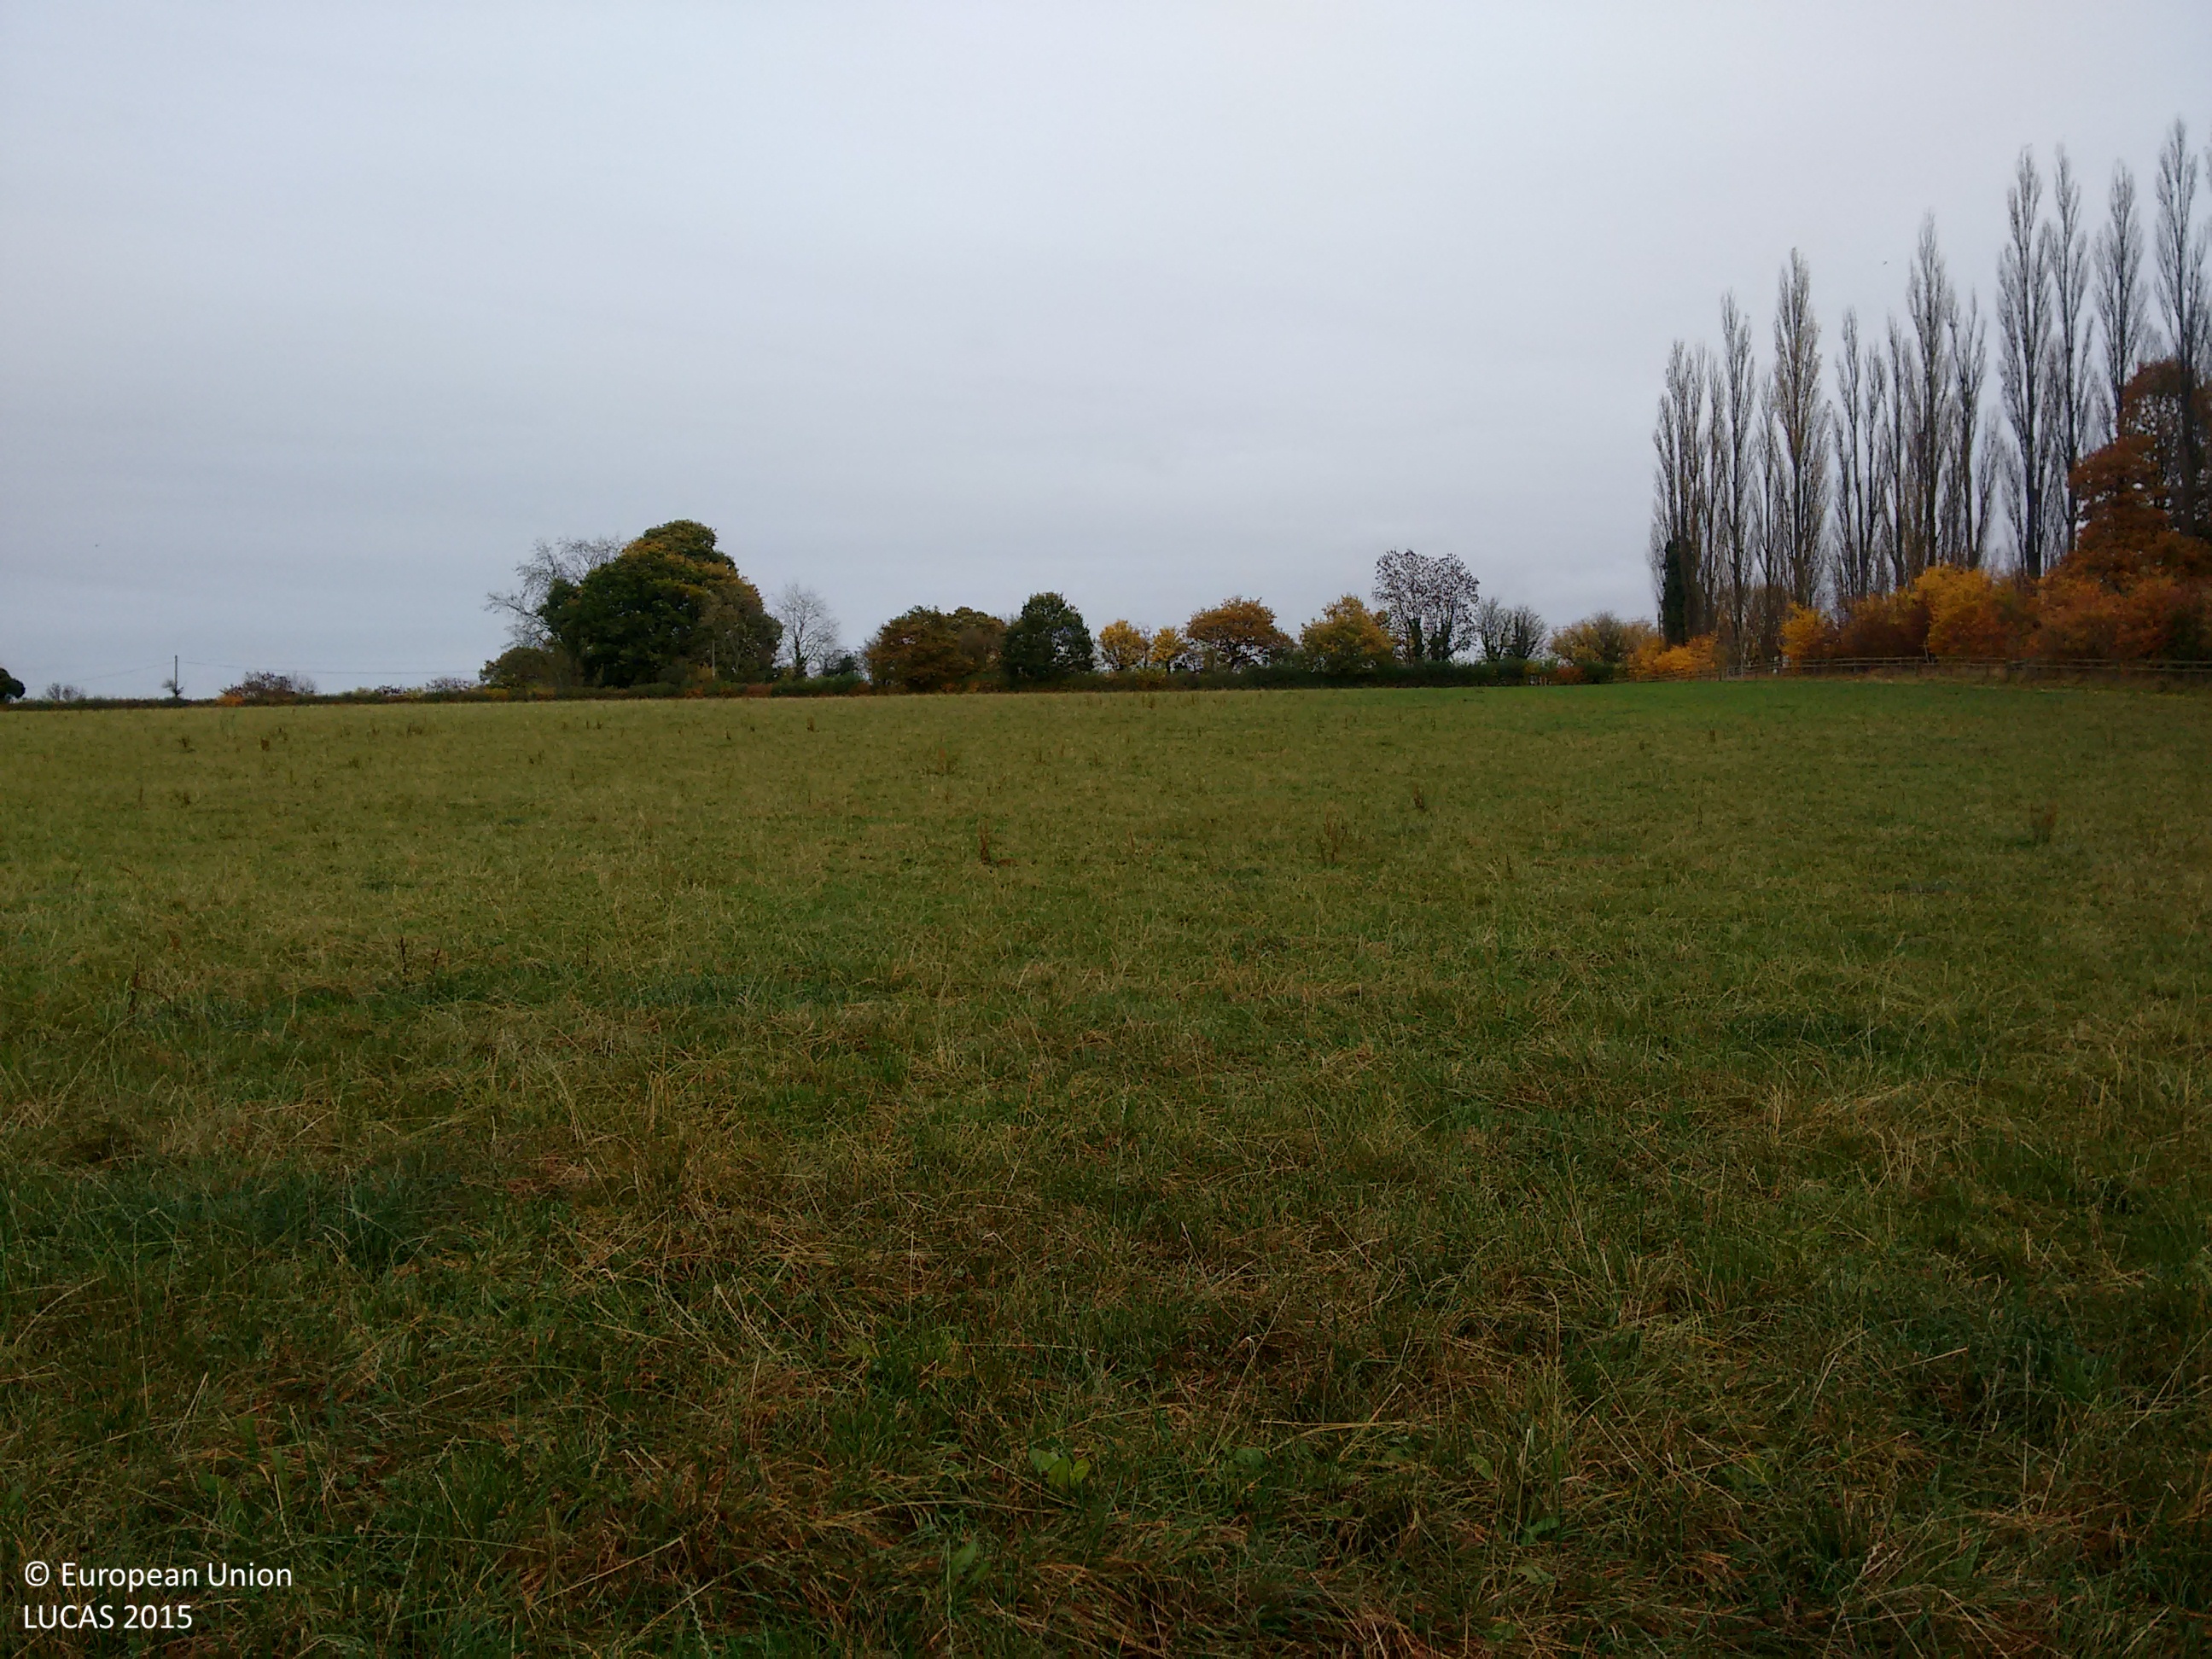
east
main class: Grassland
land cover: Grassland without tree/shrub cover
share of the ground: > 75 %
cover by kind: herbaceous plants 100 %
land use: Agriculture (excluding fallow land and kitchen gardens)
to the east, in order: Grassland without tree/shrub cover; Fences; Managed hedges; Electric lines; Paved roads, cycling and walking lanes; Managed hedges; Fences; Grassland without tree/shrub cover
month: October
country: GB
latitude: 52.3505
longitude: -2.5011
